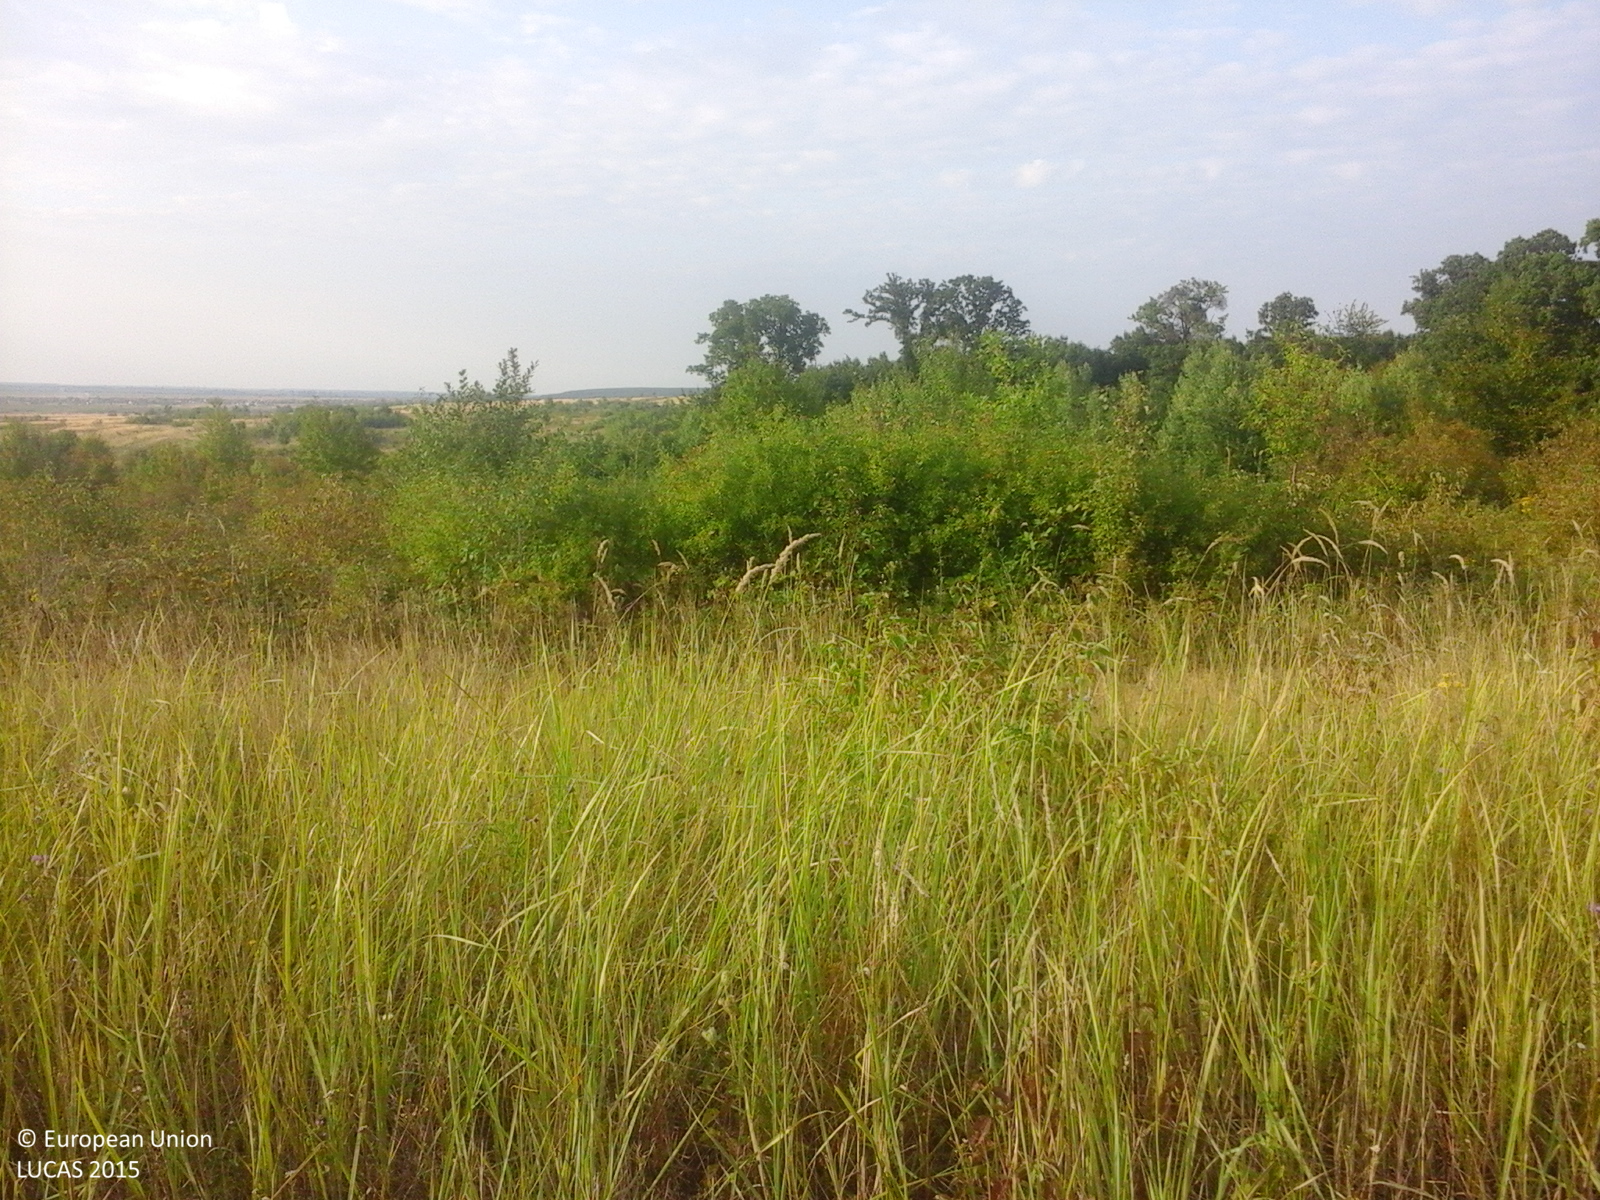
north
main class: Grassland
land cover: Grassland with sparse tree/shrub cover
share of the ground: > 75 %
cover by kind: herbaceous plants 85 %, shrubs 10 %, broadleaved forest trees 5 %
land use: Semi-natural and natural areas not in use
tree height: < 5 m
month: August
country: RO
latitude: 46.5312
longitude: 21.9736
